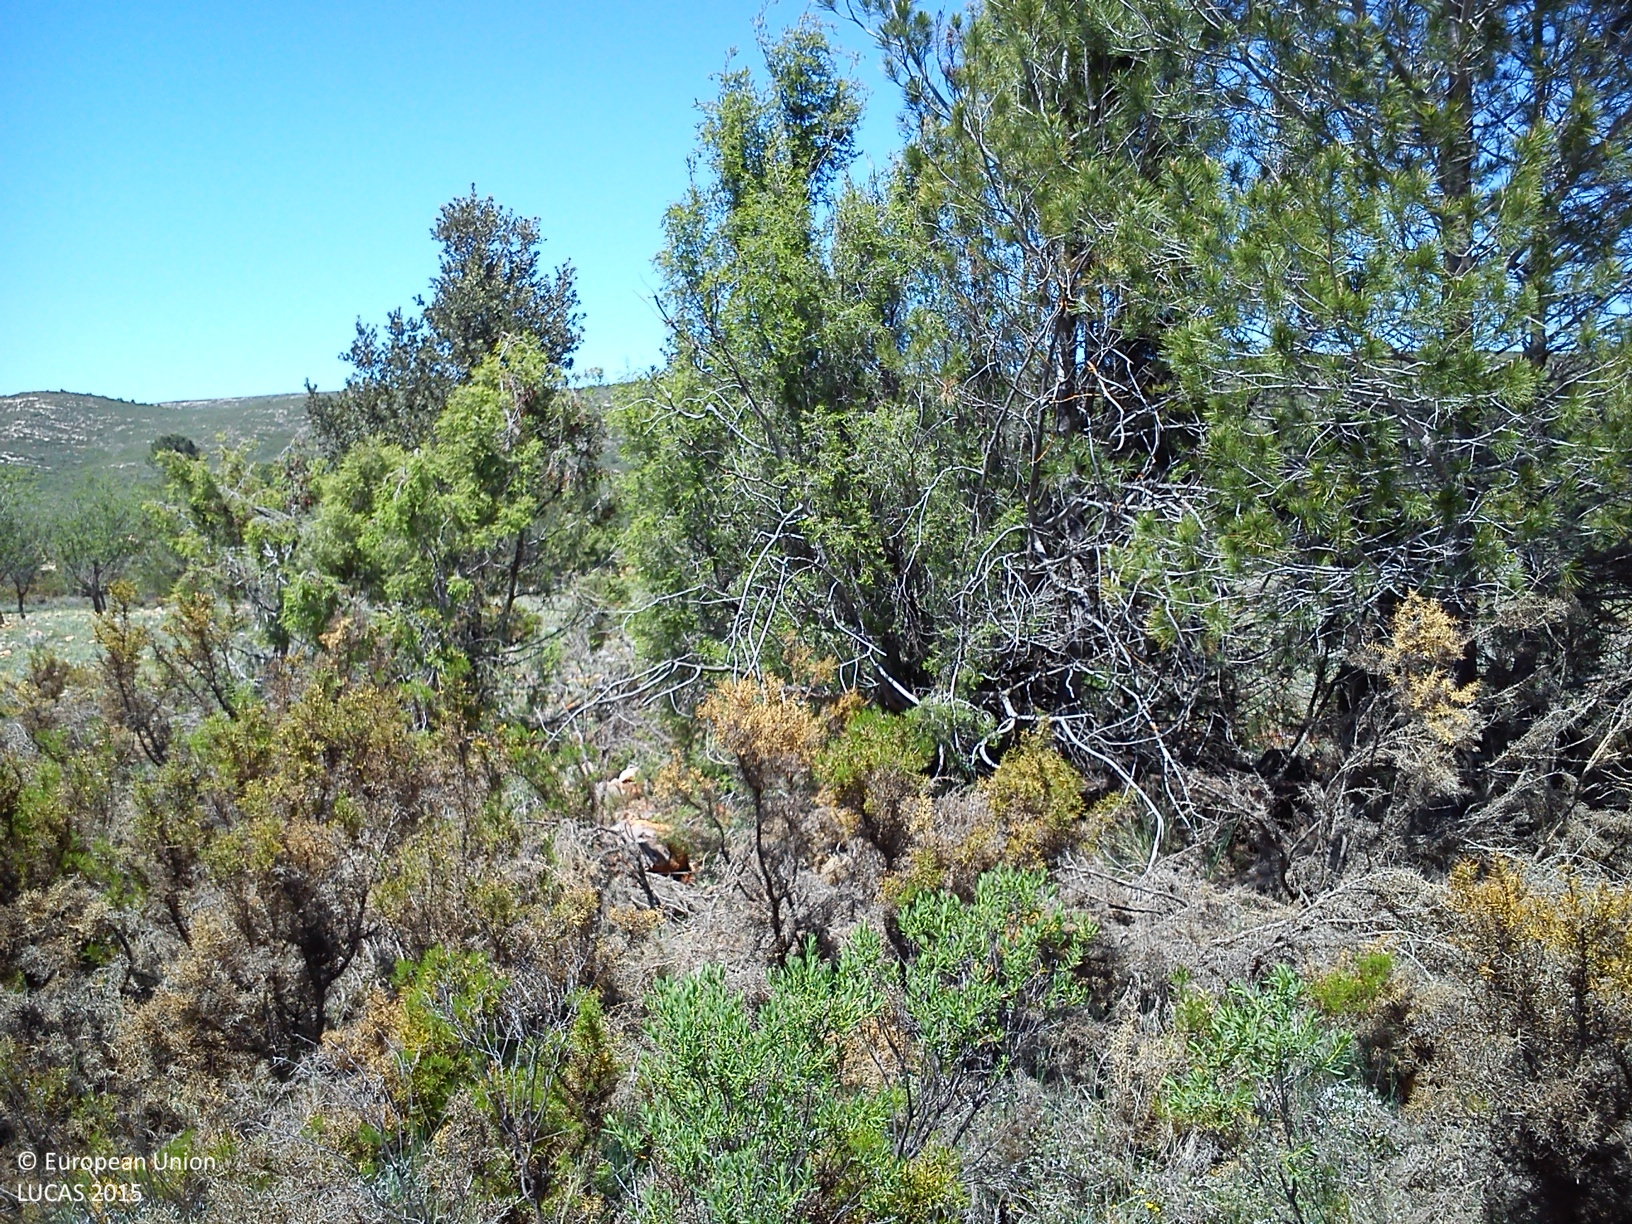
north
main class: Woodland
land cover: Pine dominated coniferous woodland
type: coniferous forest of the mediterranean region
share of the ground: > 75 %
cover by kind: shrubs 55 %, coniferous forest trees 35 %, herbaceous plants 10 %
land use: Semi-natural and natural areas not in use
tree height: > 5 m
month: May
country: ES
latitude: 39.5660
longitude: -0.9077
